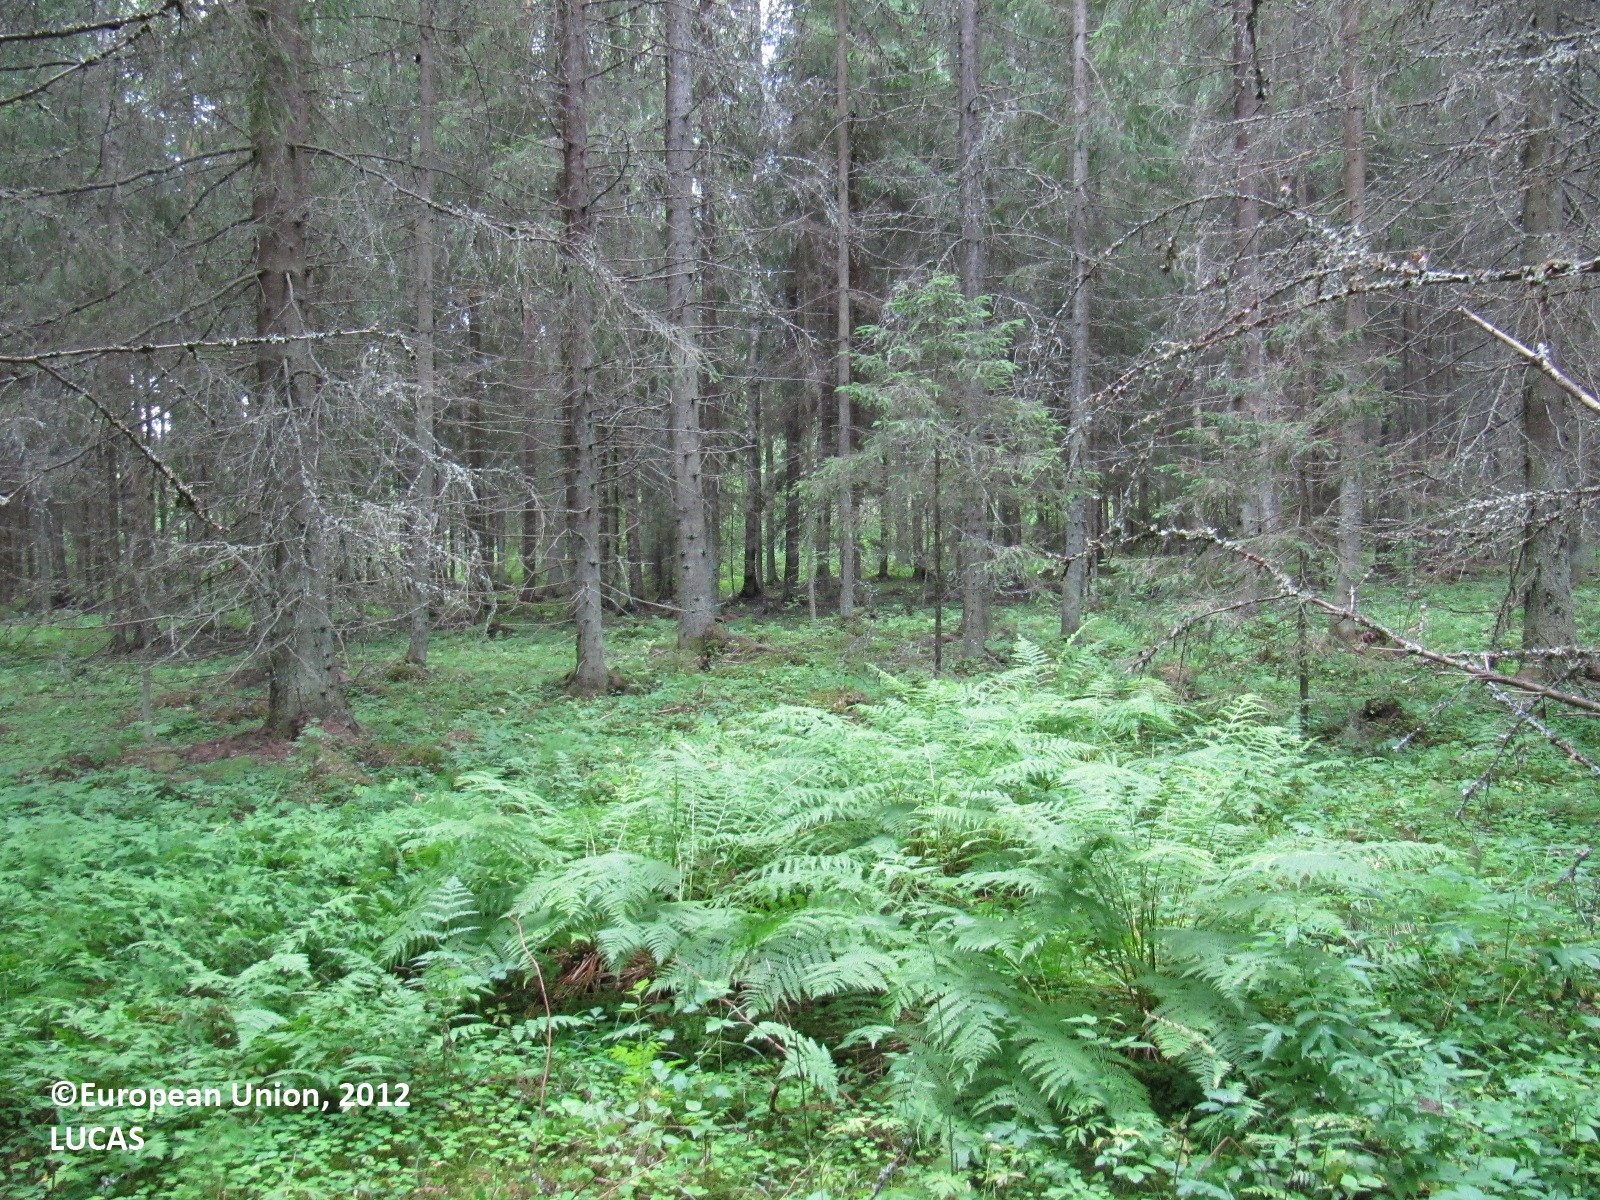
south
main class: Woodland
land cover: Spruce dominated coniferous woodland
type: boreal forest
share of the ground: > 75 %
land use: Forestry
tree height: > 5 m
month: July
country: FI
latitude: 60.9889
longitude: 24.6531
